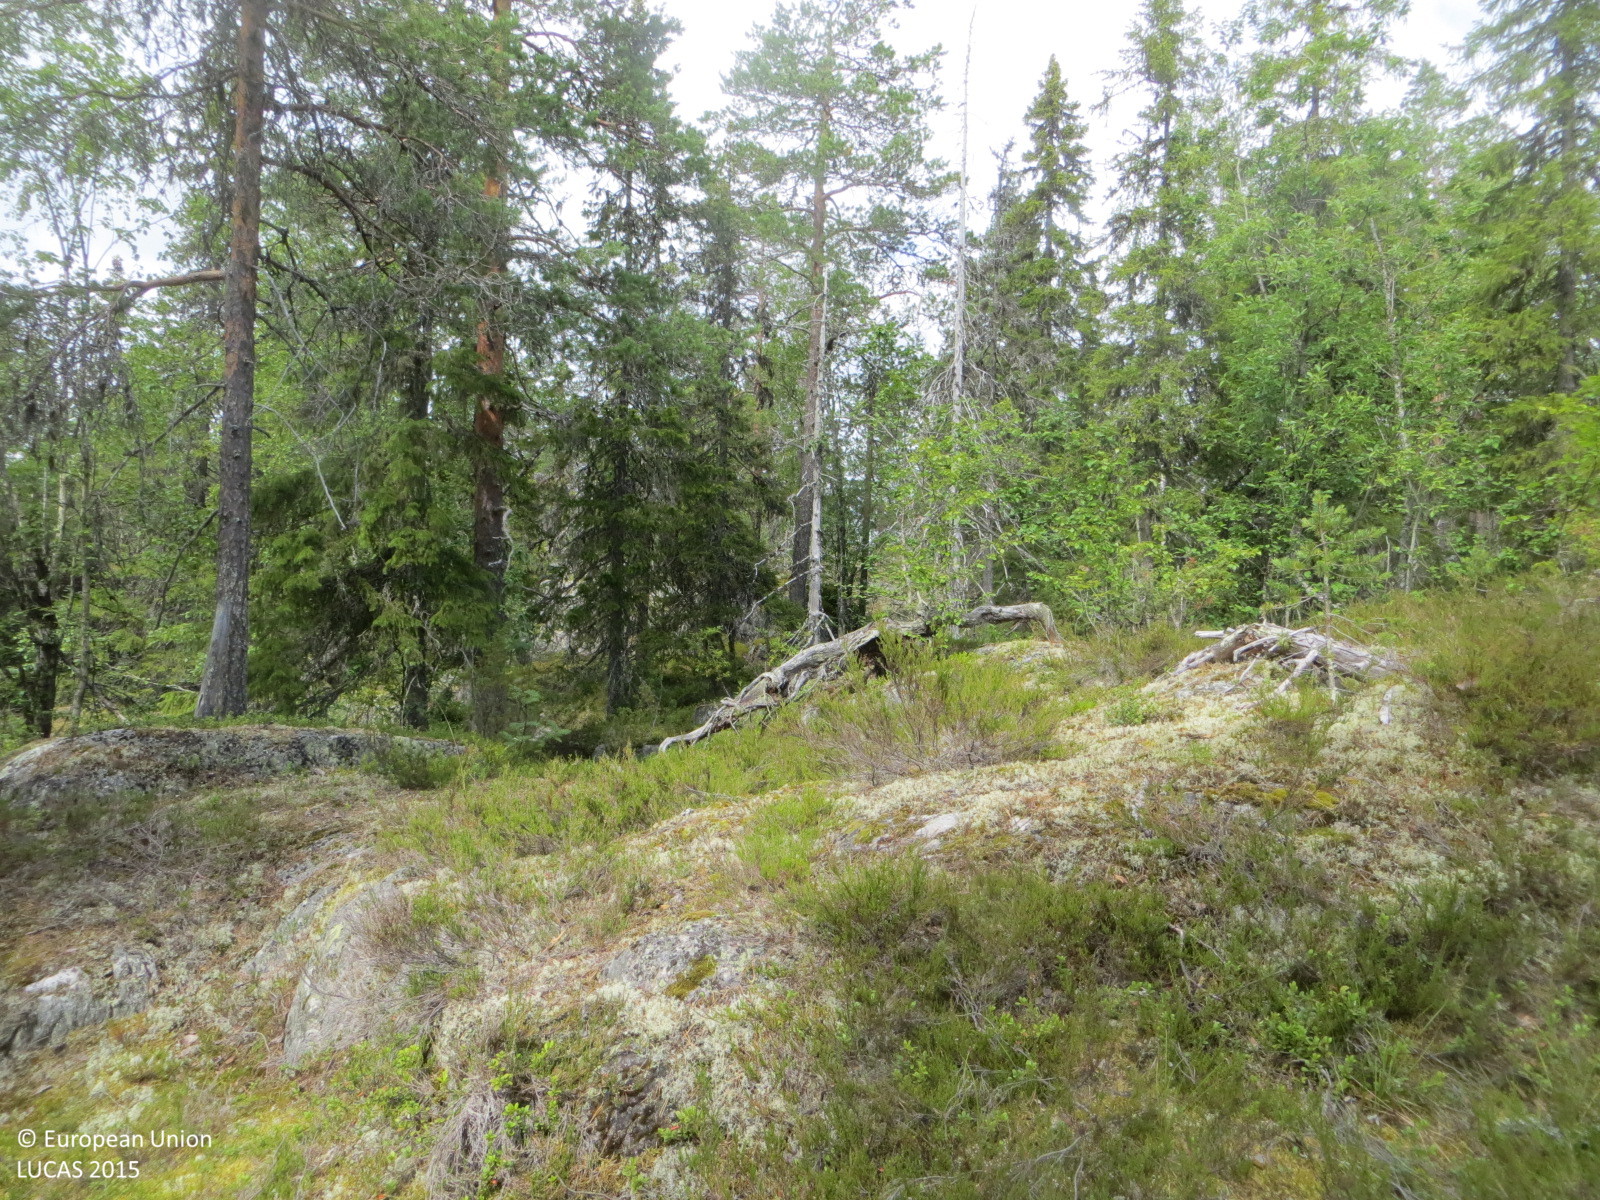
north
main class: Woodland
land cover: Other mixed woodland
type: boreal forest
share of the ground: 50 - 75 %
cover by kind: coniferous forest trees 40 %, broadleaved forest trees 25 %, shrubs 20 %, unconsolidated bare surface 15 %
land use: Forestry
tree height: > 5 m
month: July
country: FI
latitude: 66.1166
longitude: 23.9631
